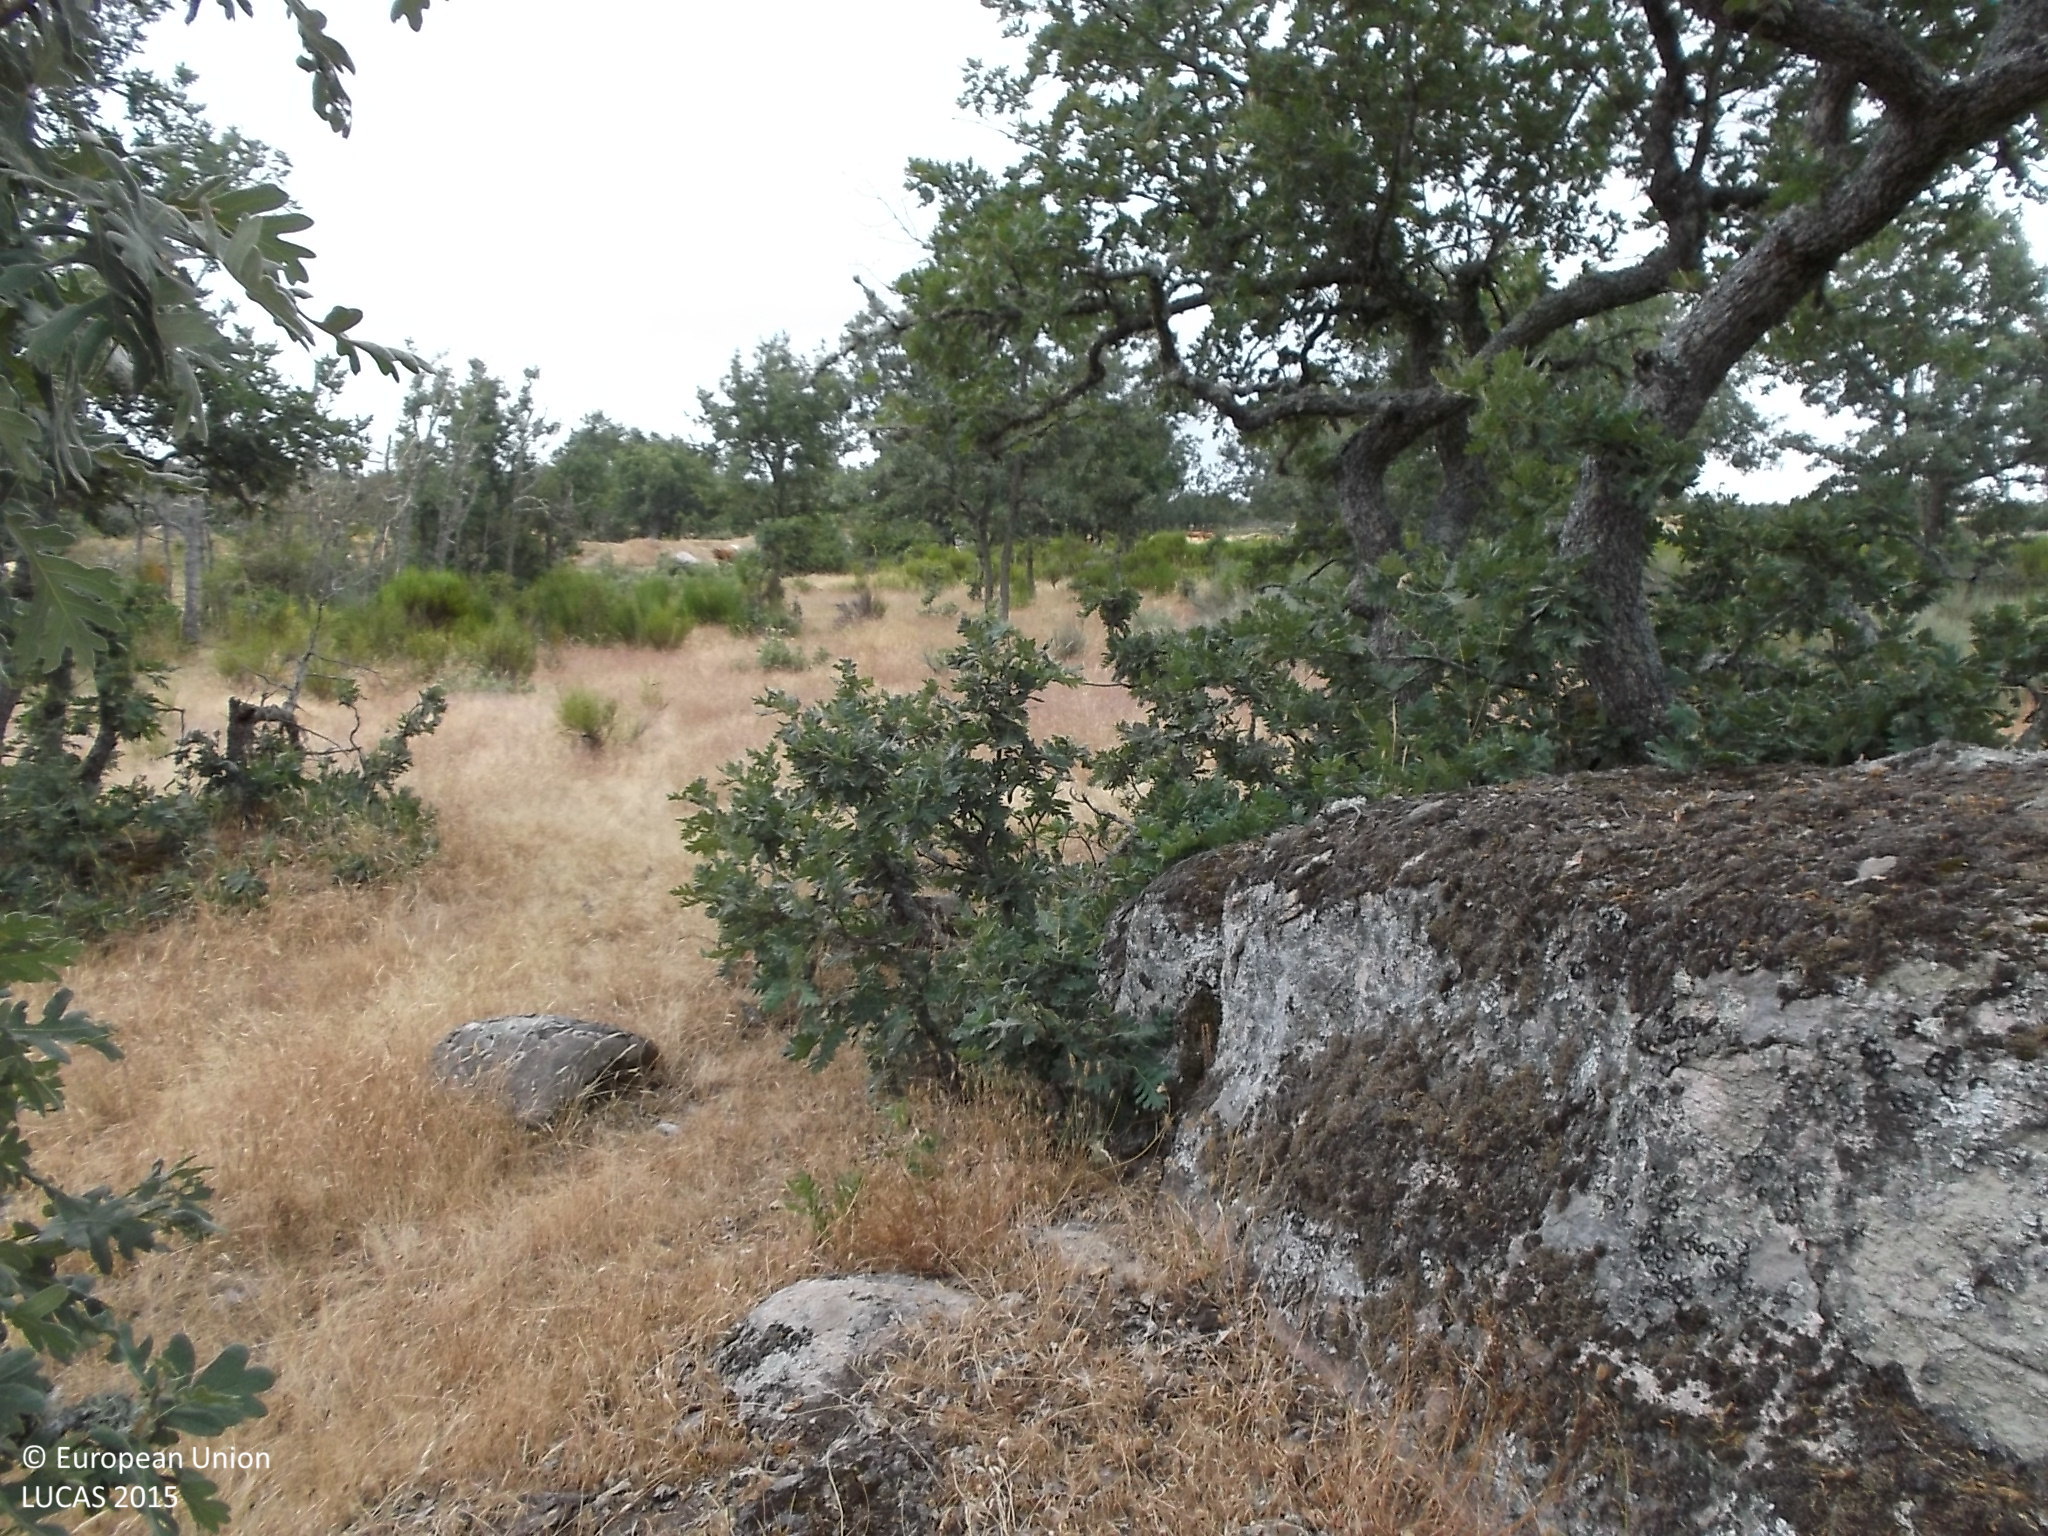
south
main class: Woodland
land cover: Broadleaved woodland
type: broadleaved evergreen forest
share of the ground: 25 - 50 %
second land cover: Grassland without tree/shrub cover
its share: 25 - 50 %
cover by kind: broadleaved forest trees 40 %, herbaceous plants 40 %, shrubs 20 %
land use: Forestry
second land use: Agriculture (excluding fallow land and kitchen gardens)
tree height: < 5 m
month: July
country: ES
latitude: 41.2007
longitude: -6.3727
